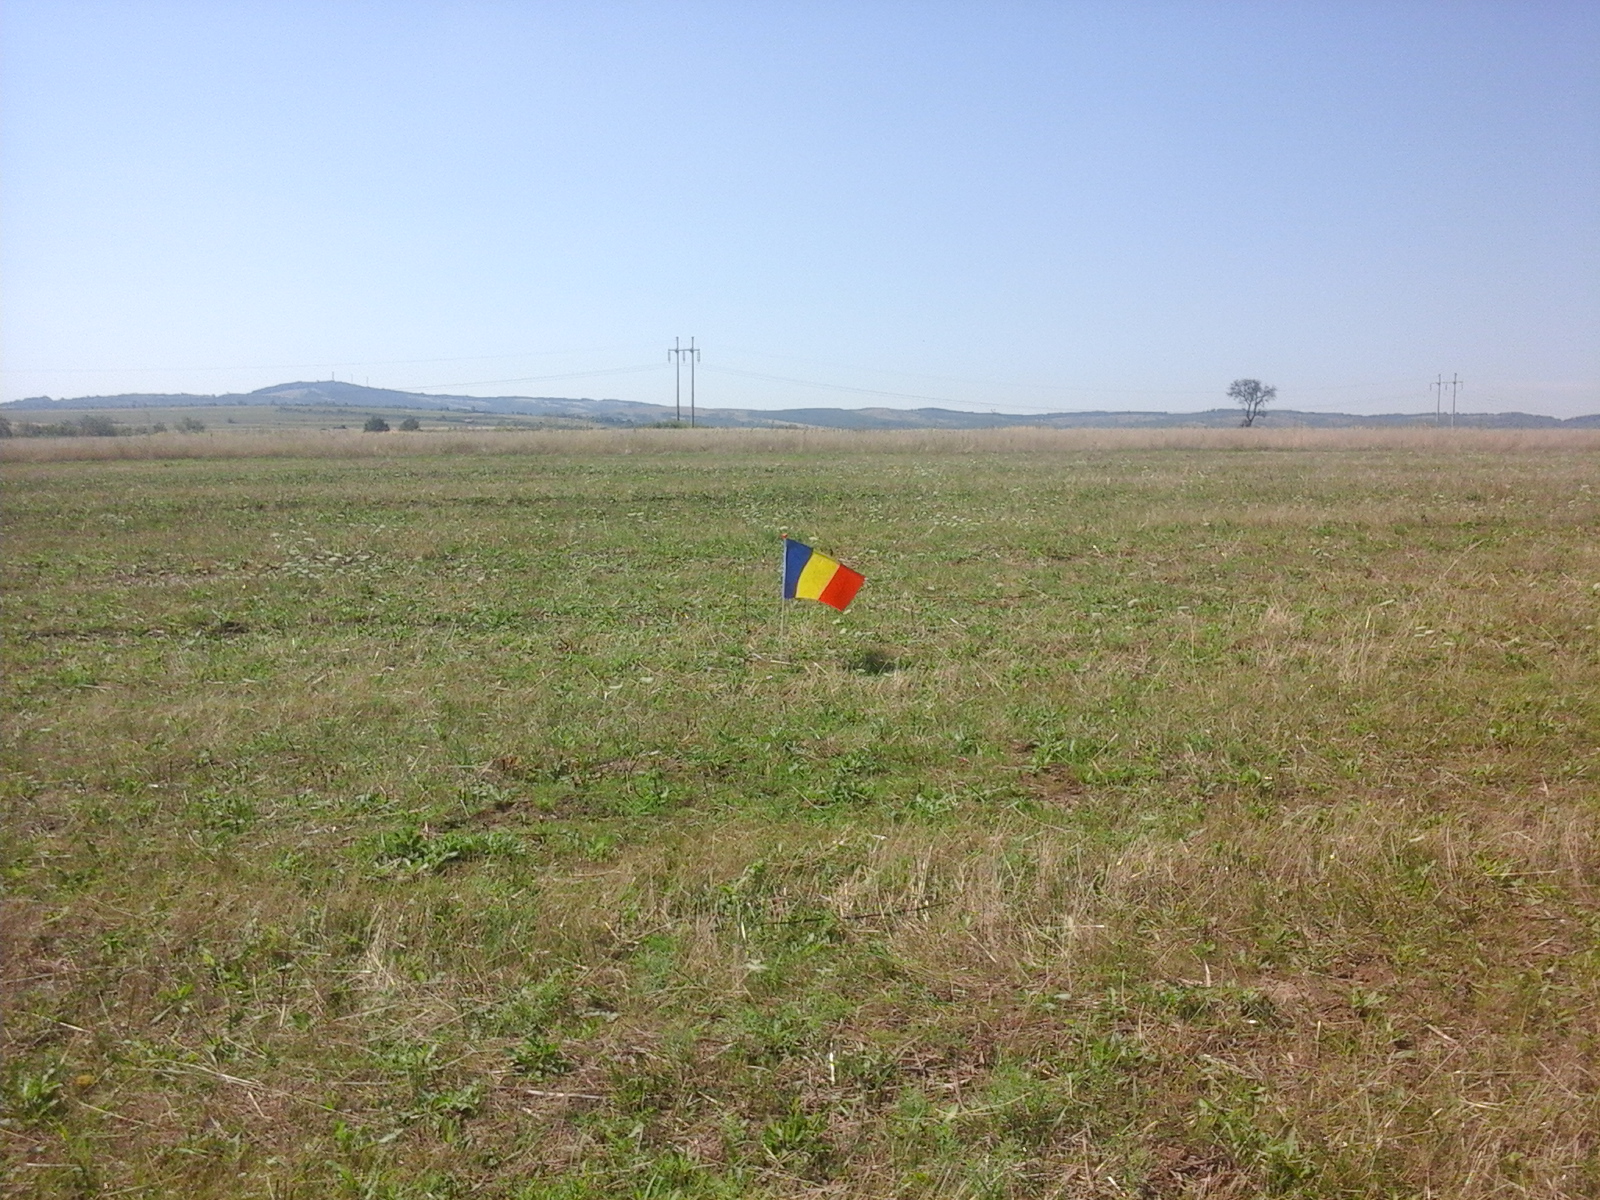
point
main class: Cropland
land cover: Common wheat
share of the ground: 25 - 50 %
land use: Agriculture (excluding fallow land and kitchen gardens)
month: August
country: RO
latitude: 45.6109
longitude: 21.7431
